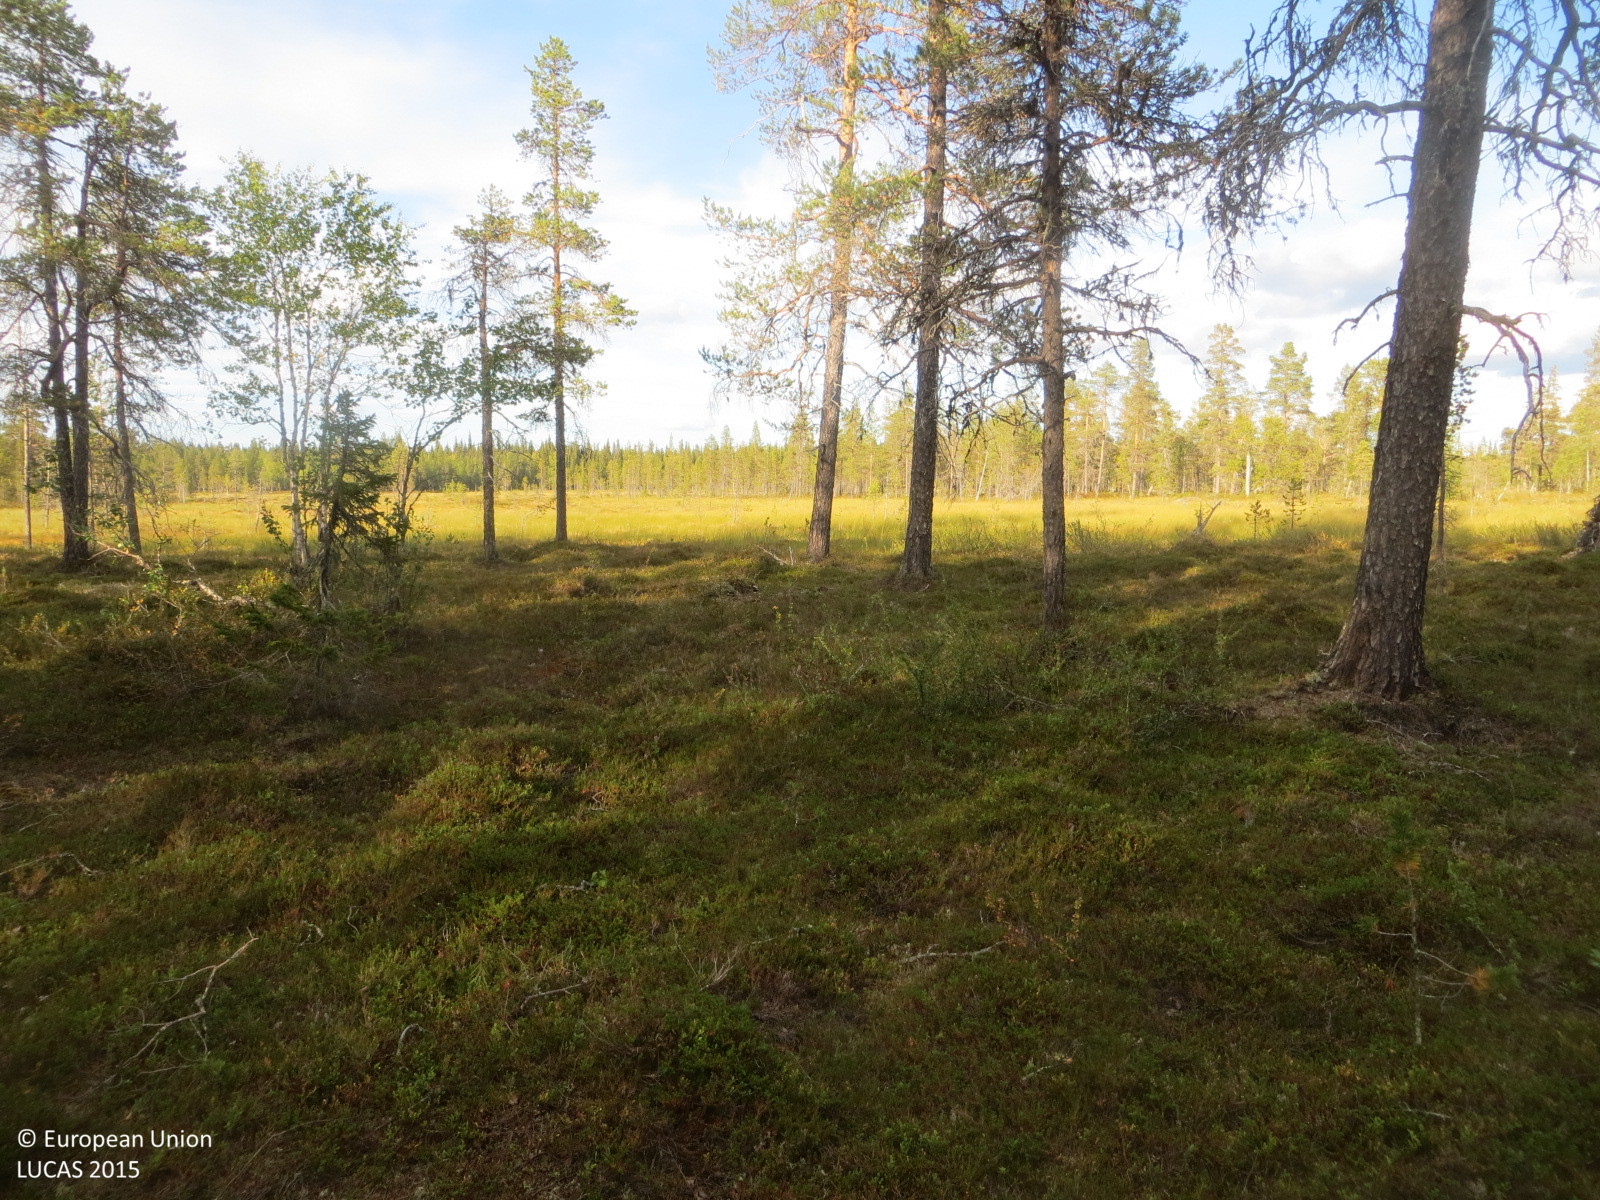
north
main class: Woodland
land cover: Pine dominated coniferous woodland
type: boreal forest
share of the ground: 50 - 75 %
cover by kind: shrubs 50 %, coniferous forest trees 45 %, broadleaved forest trees 5 %
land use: Forestry
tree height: > 5 m
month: August
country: FI
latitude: 68.2123
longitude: 25.6610
